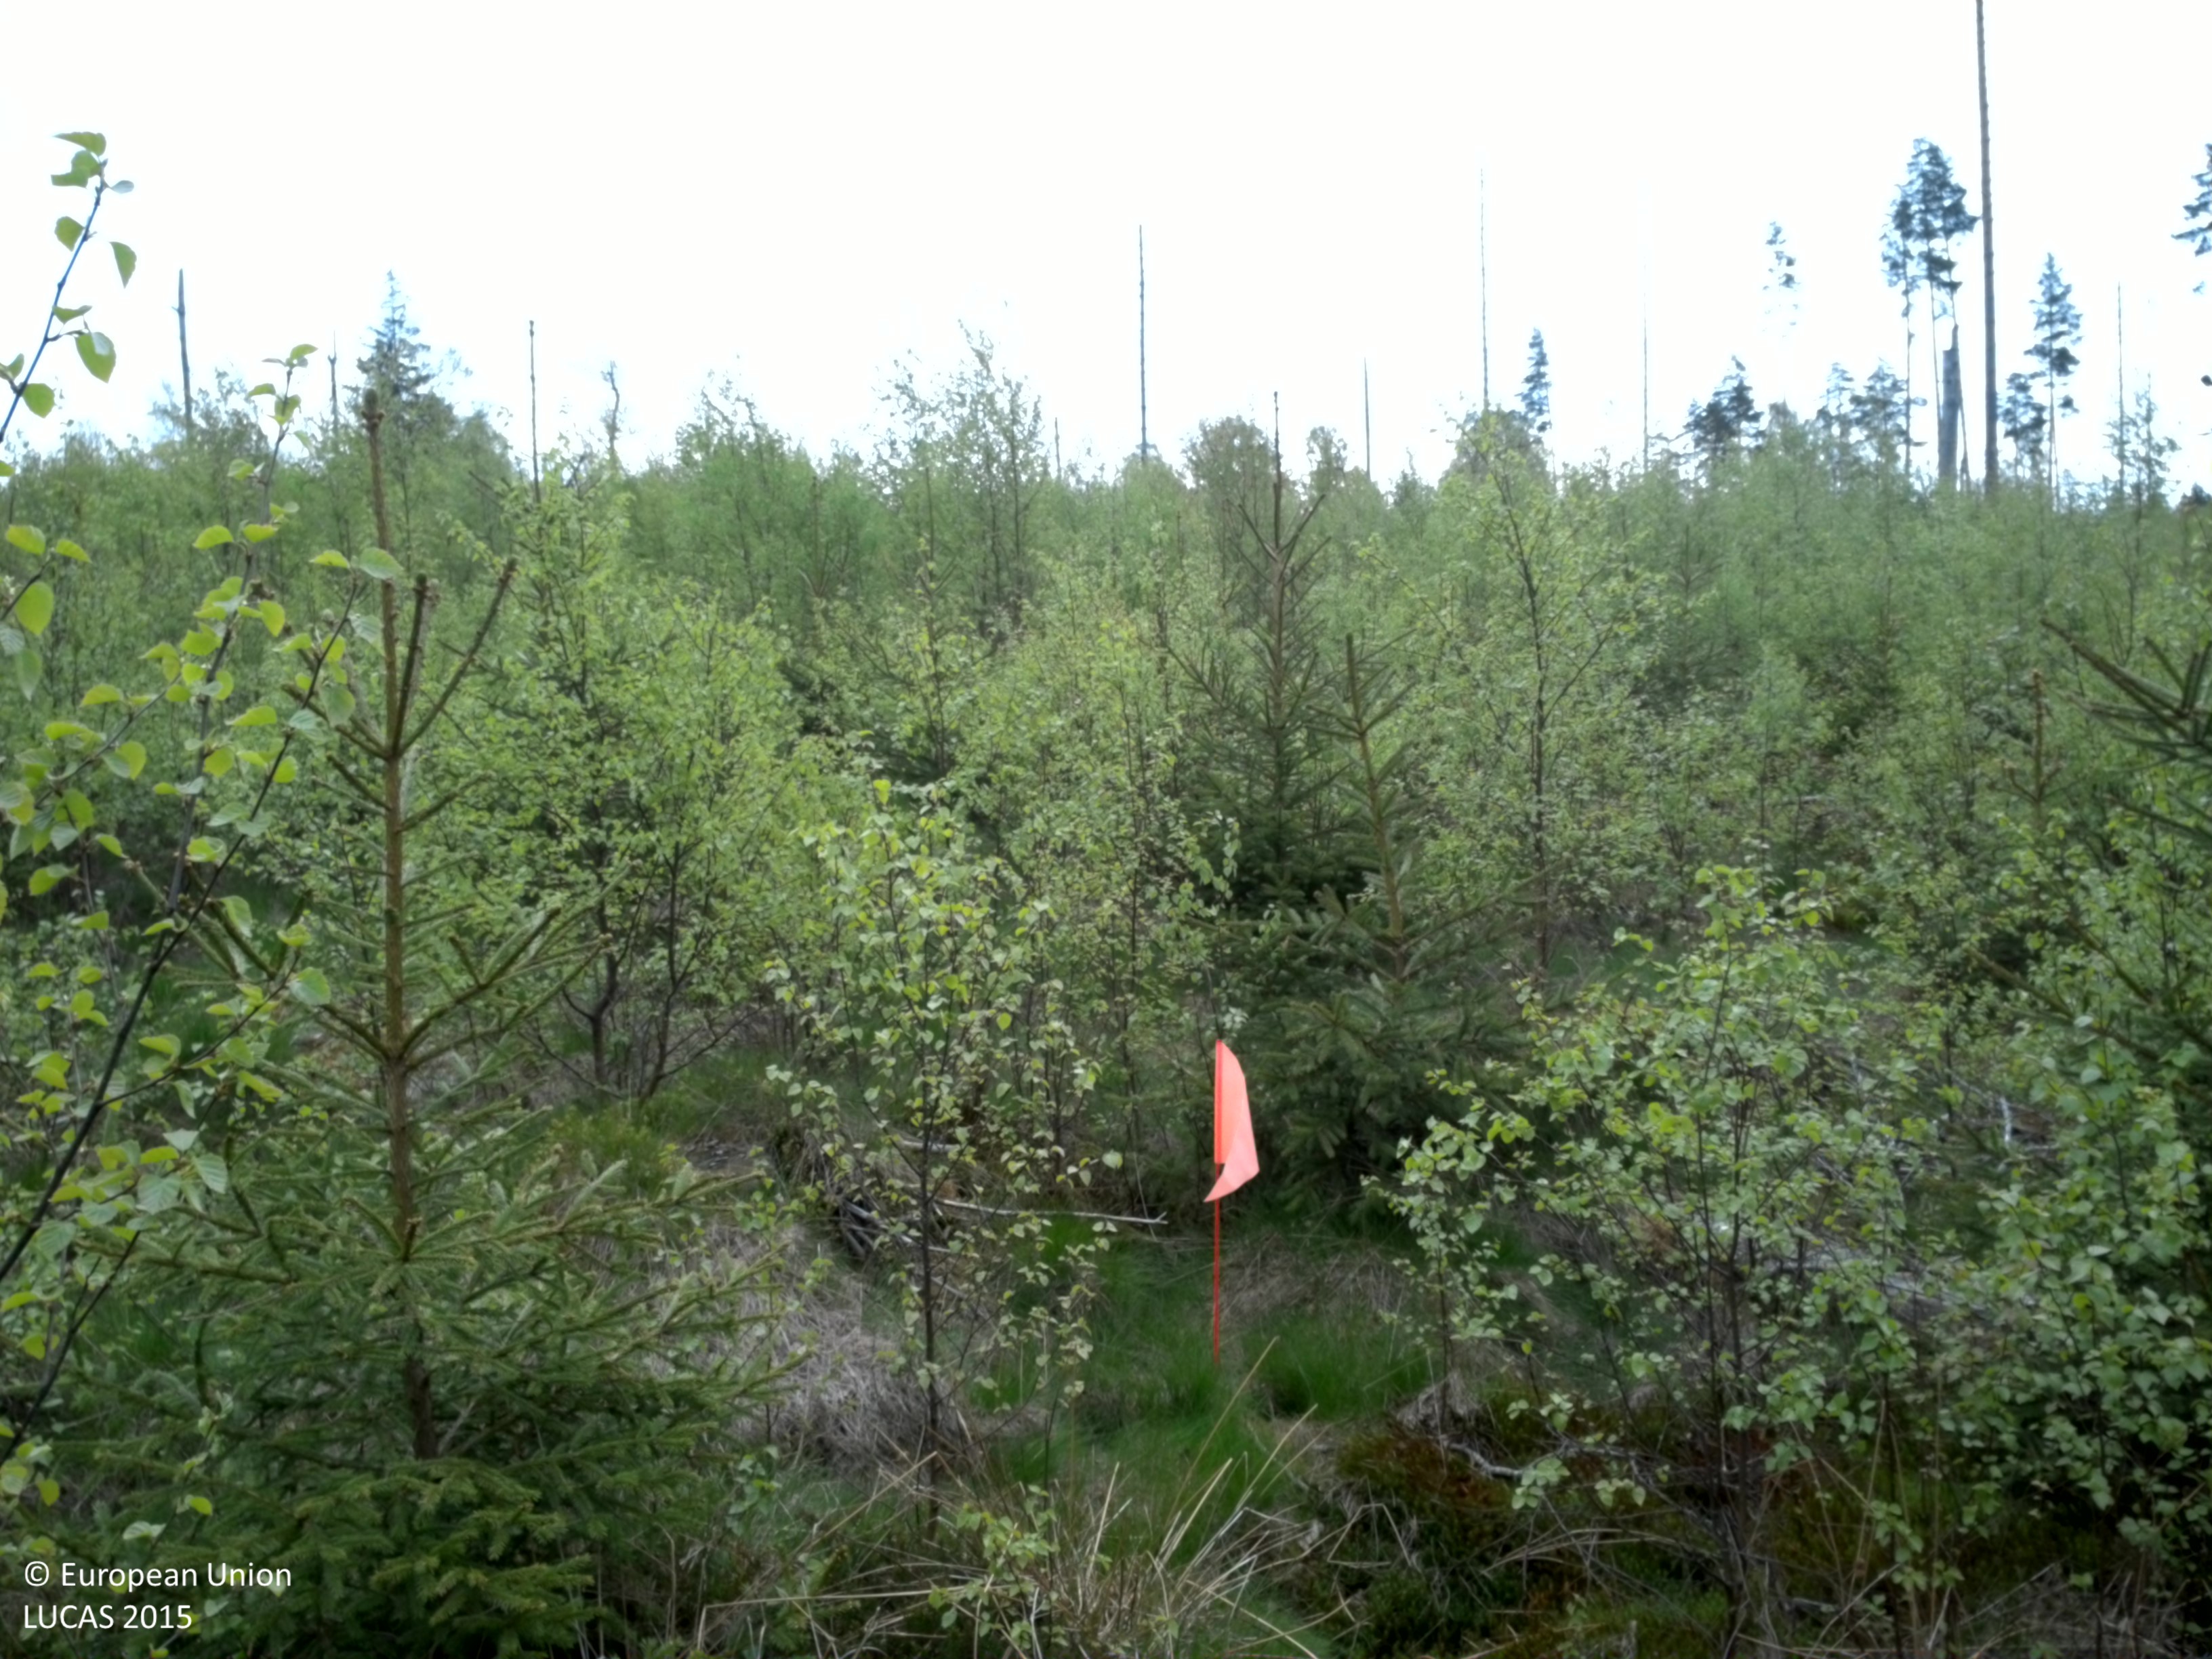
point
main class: Woodland
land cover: Spruce dominated mixed woodland
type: boreal forest
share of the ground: 50 - 75 %
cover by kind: broadleaved forest trees 40 %, coniferous forest trees 35 %, shrubs 10 %, herbaceous plants 10 %, lichens and mosses 5 %
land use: Forestry
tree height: < 5 m
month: May
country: SE
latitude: 56.9099
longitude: 15.2366
